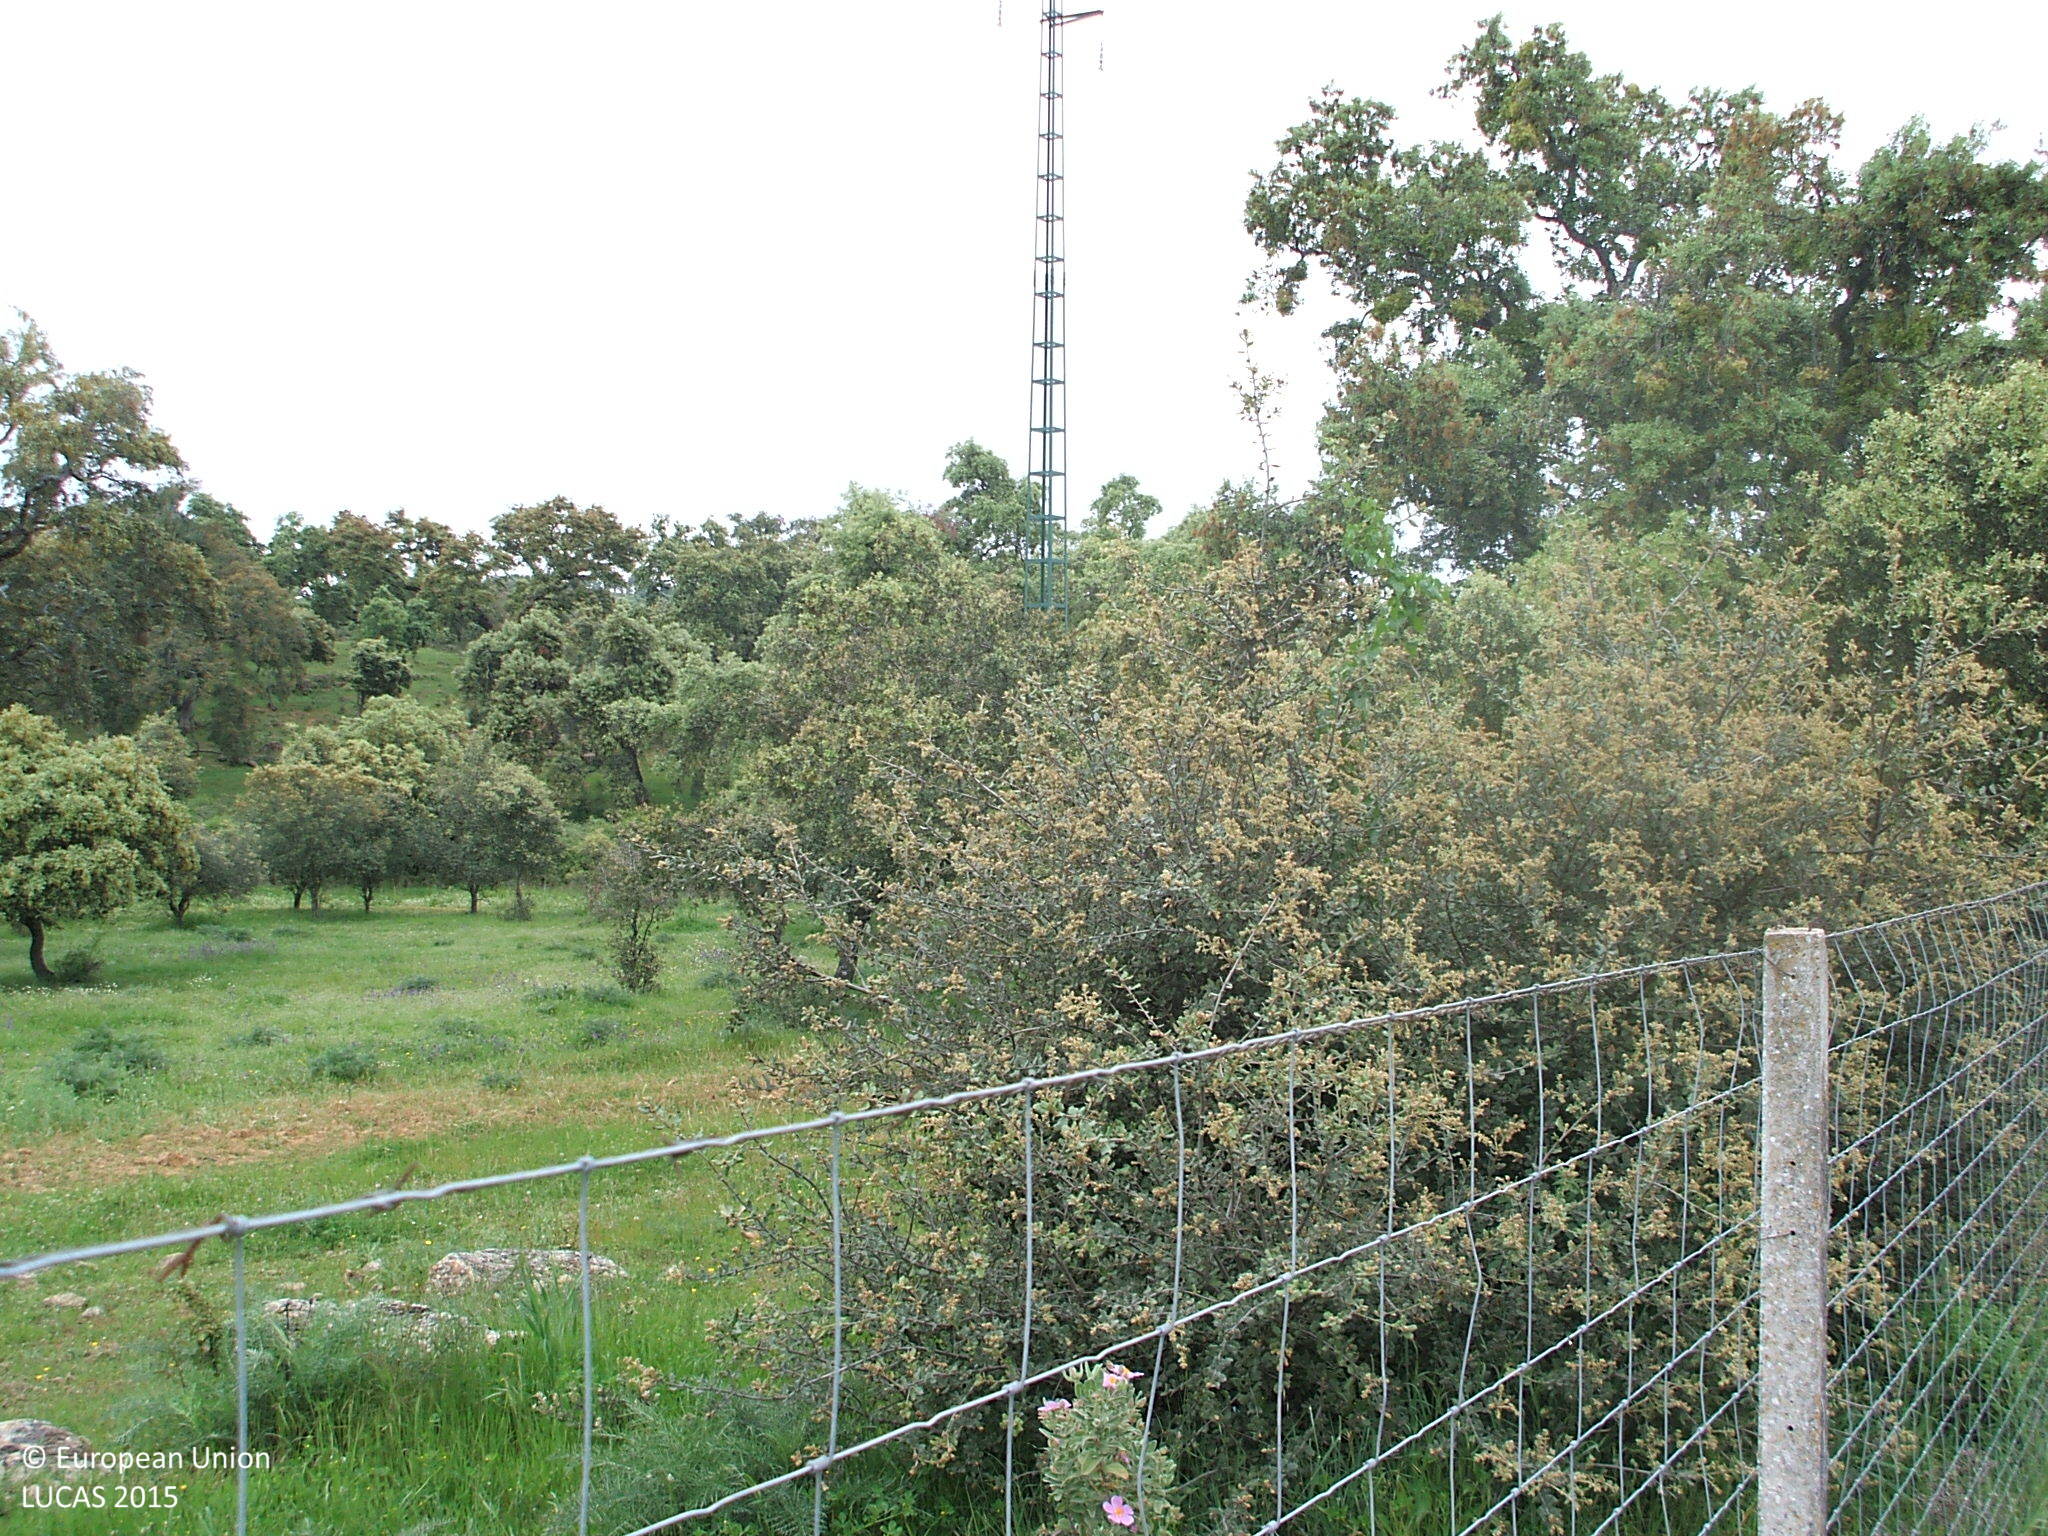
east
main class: Woodland
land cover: Broadleaved woodland
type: broadleaved evergreen forest
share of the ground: 10 - 25 %
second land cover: Grassland without tree/shrub cover
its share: > 75 %
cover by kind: herbaceous plants 80 %, broadleaved forest trees 20 %
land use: Forestry
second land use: Agriculture (excluding fallow land and kitchen gardens)
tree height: > 5 m
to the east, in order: Broadleaved woodland; Grassland without tree/shrub cover; Fences; Grassland without tree/shrub cover; Paved roads, cycling and walking lanes; Grassland without tree/shrub cover; Fences; Broadleaved woodland; Grassland without tree/shrub cover; Grassland with sparse tree/shrub cover
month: April
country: ES
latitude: 38.0416
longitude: -5.6750
